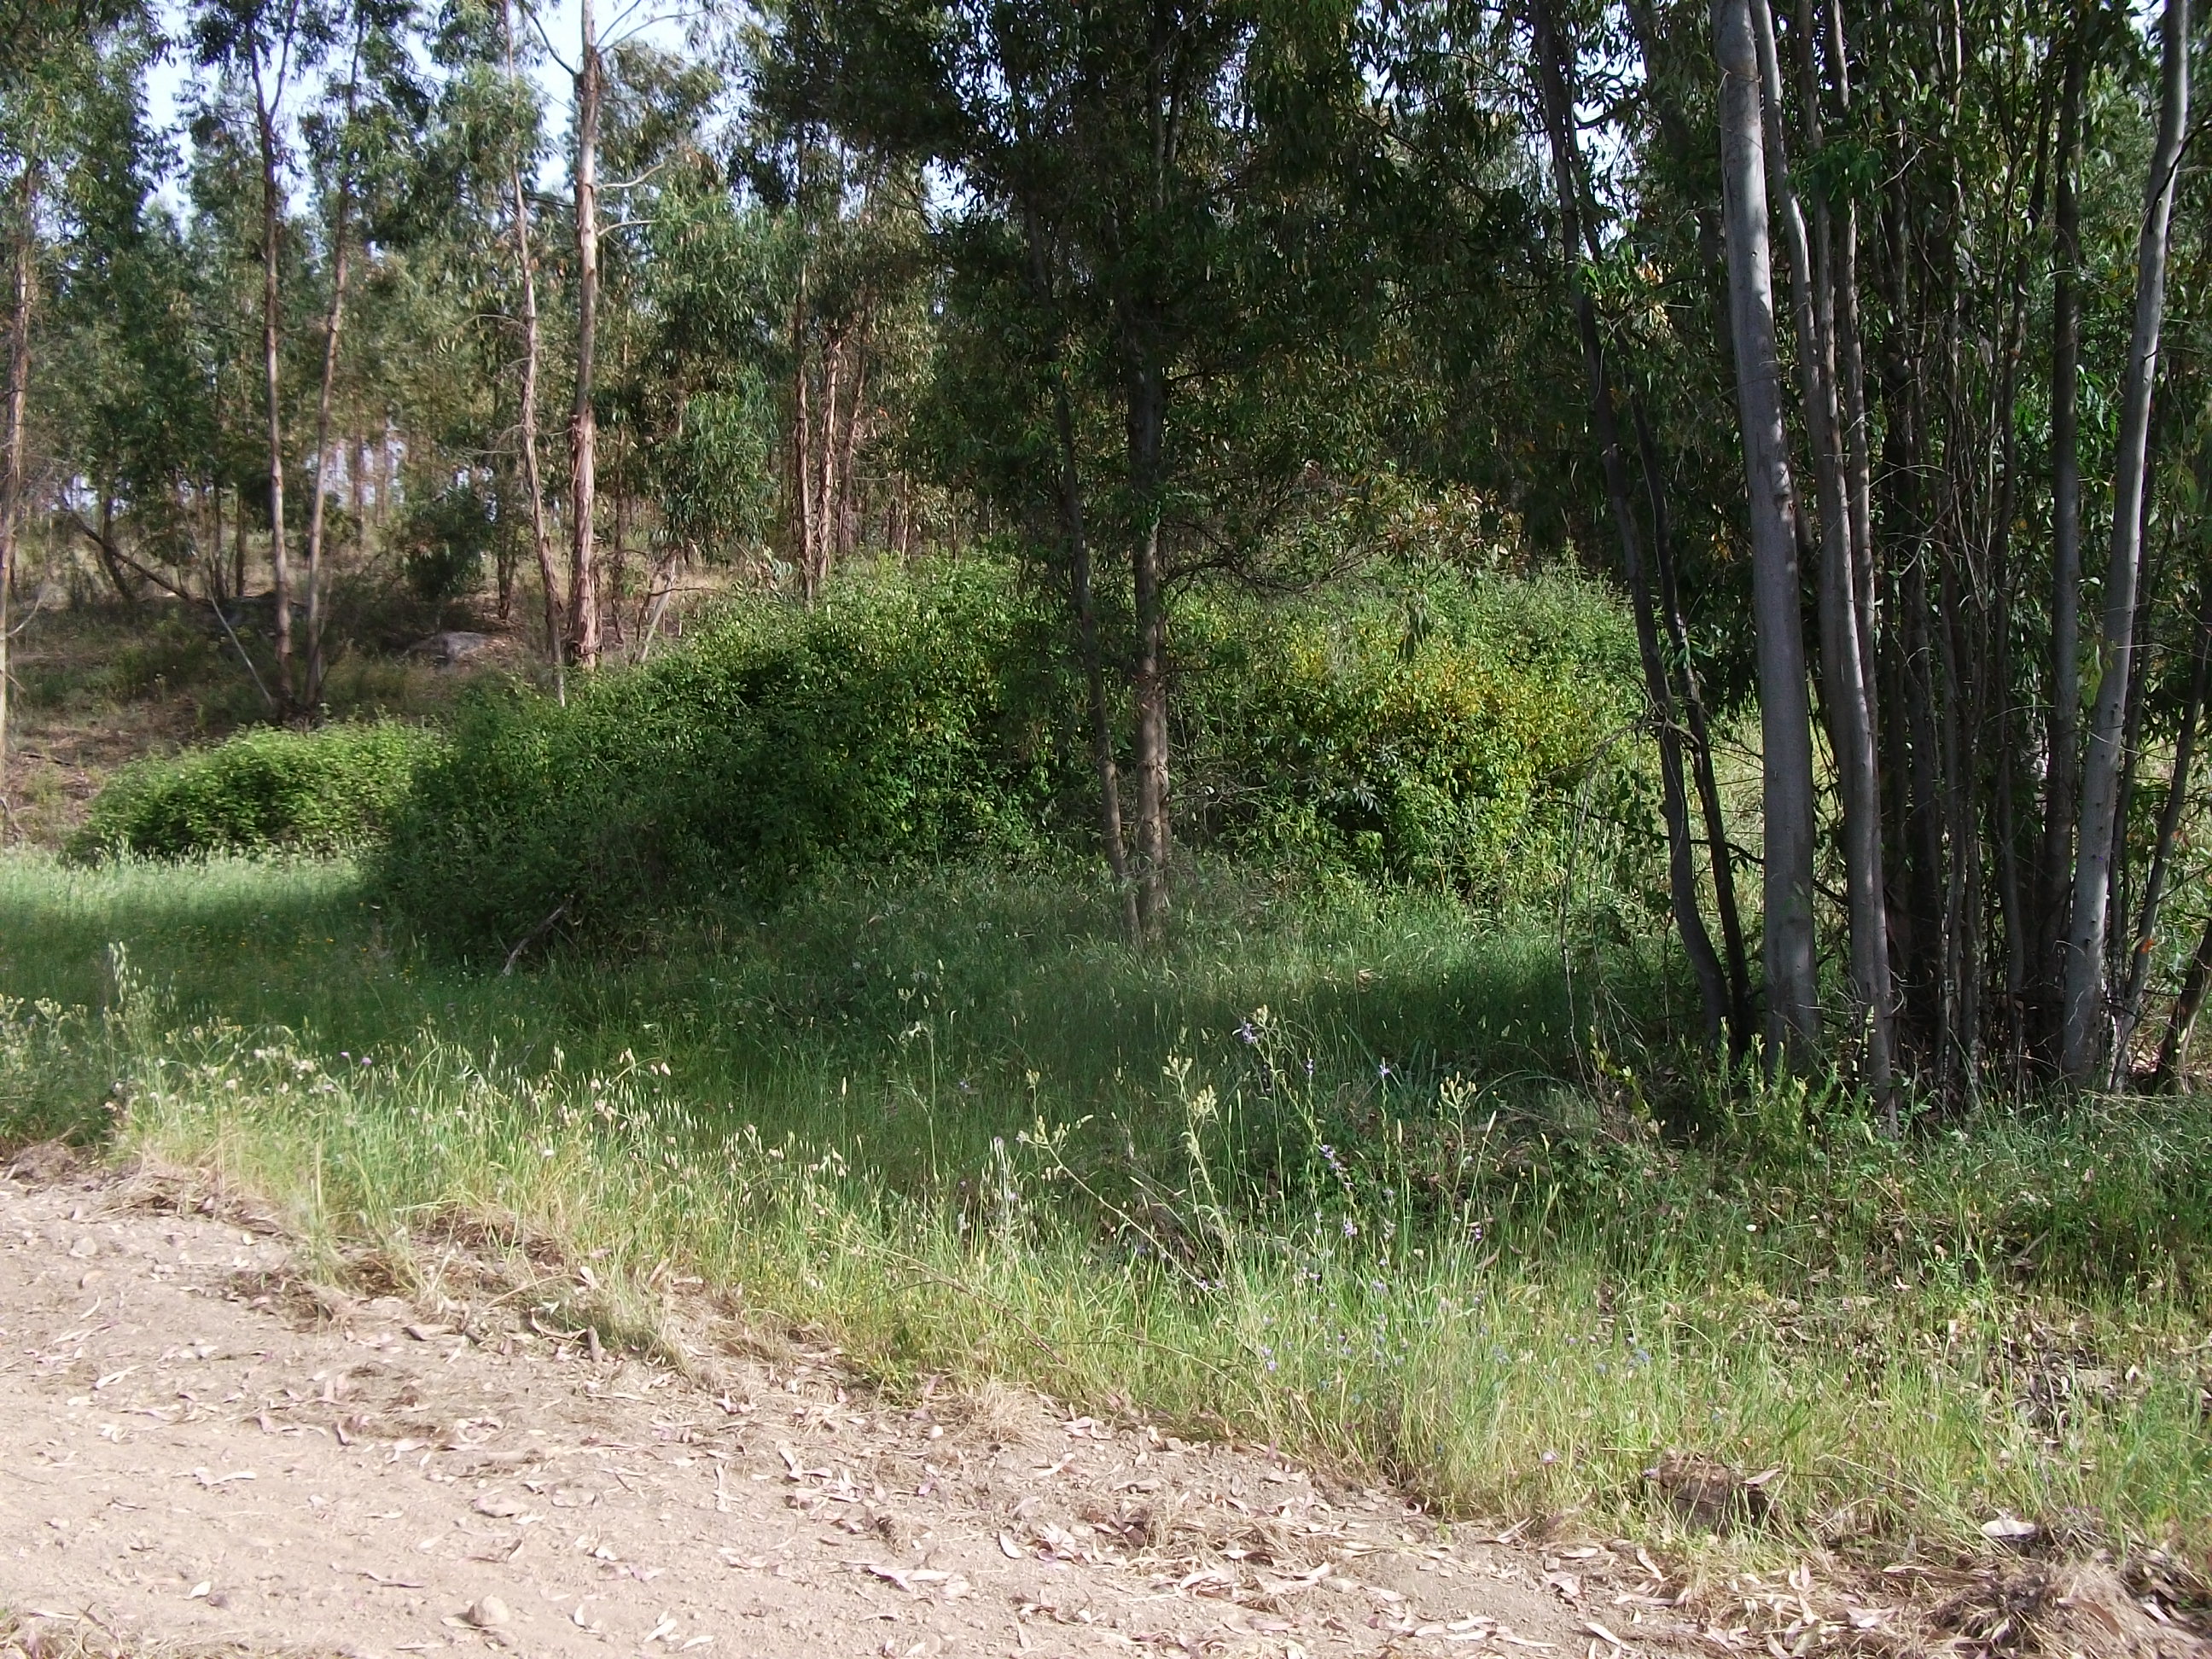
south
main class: Woodland
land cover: Broadleaved woodland
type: exotic forest
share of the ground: 10 - 25 %
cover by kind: herbaceous plants 80 %, broadleaved forest trees 20 %
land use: Semi-natural and natural areas not in use
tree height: > 5 m
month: May
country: ES
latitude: 37.6906
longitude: -6.9557
